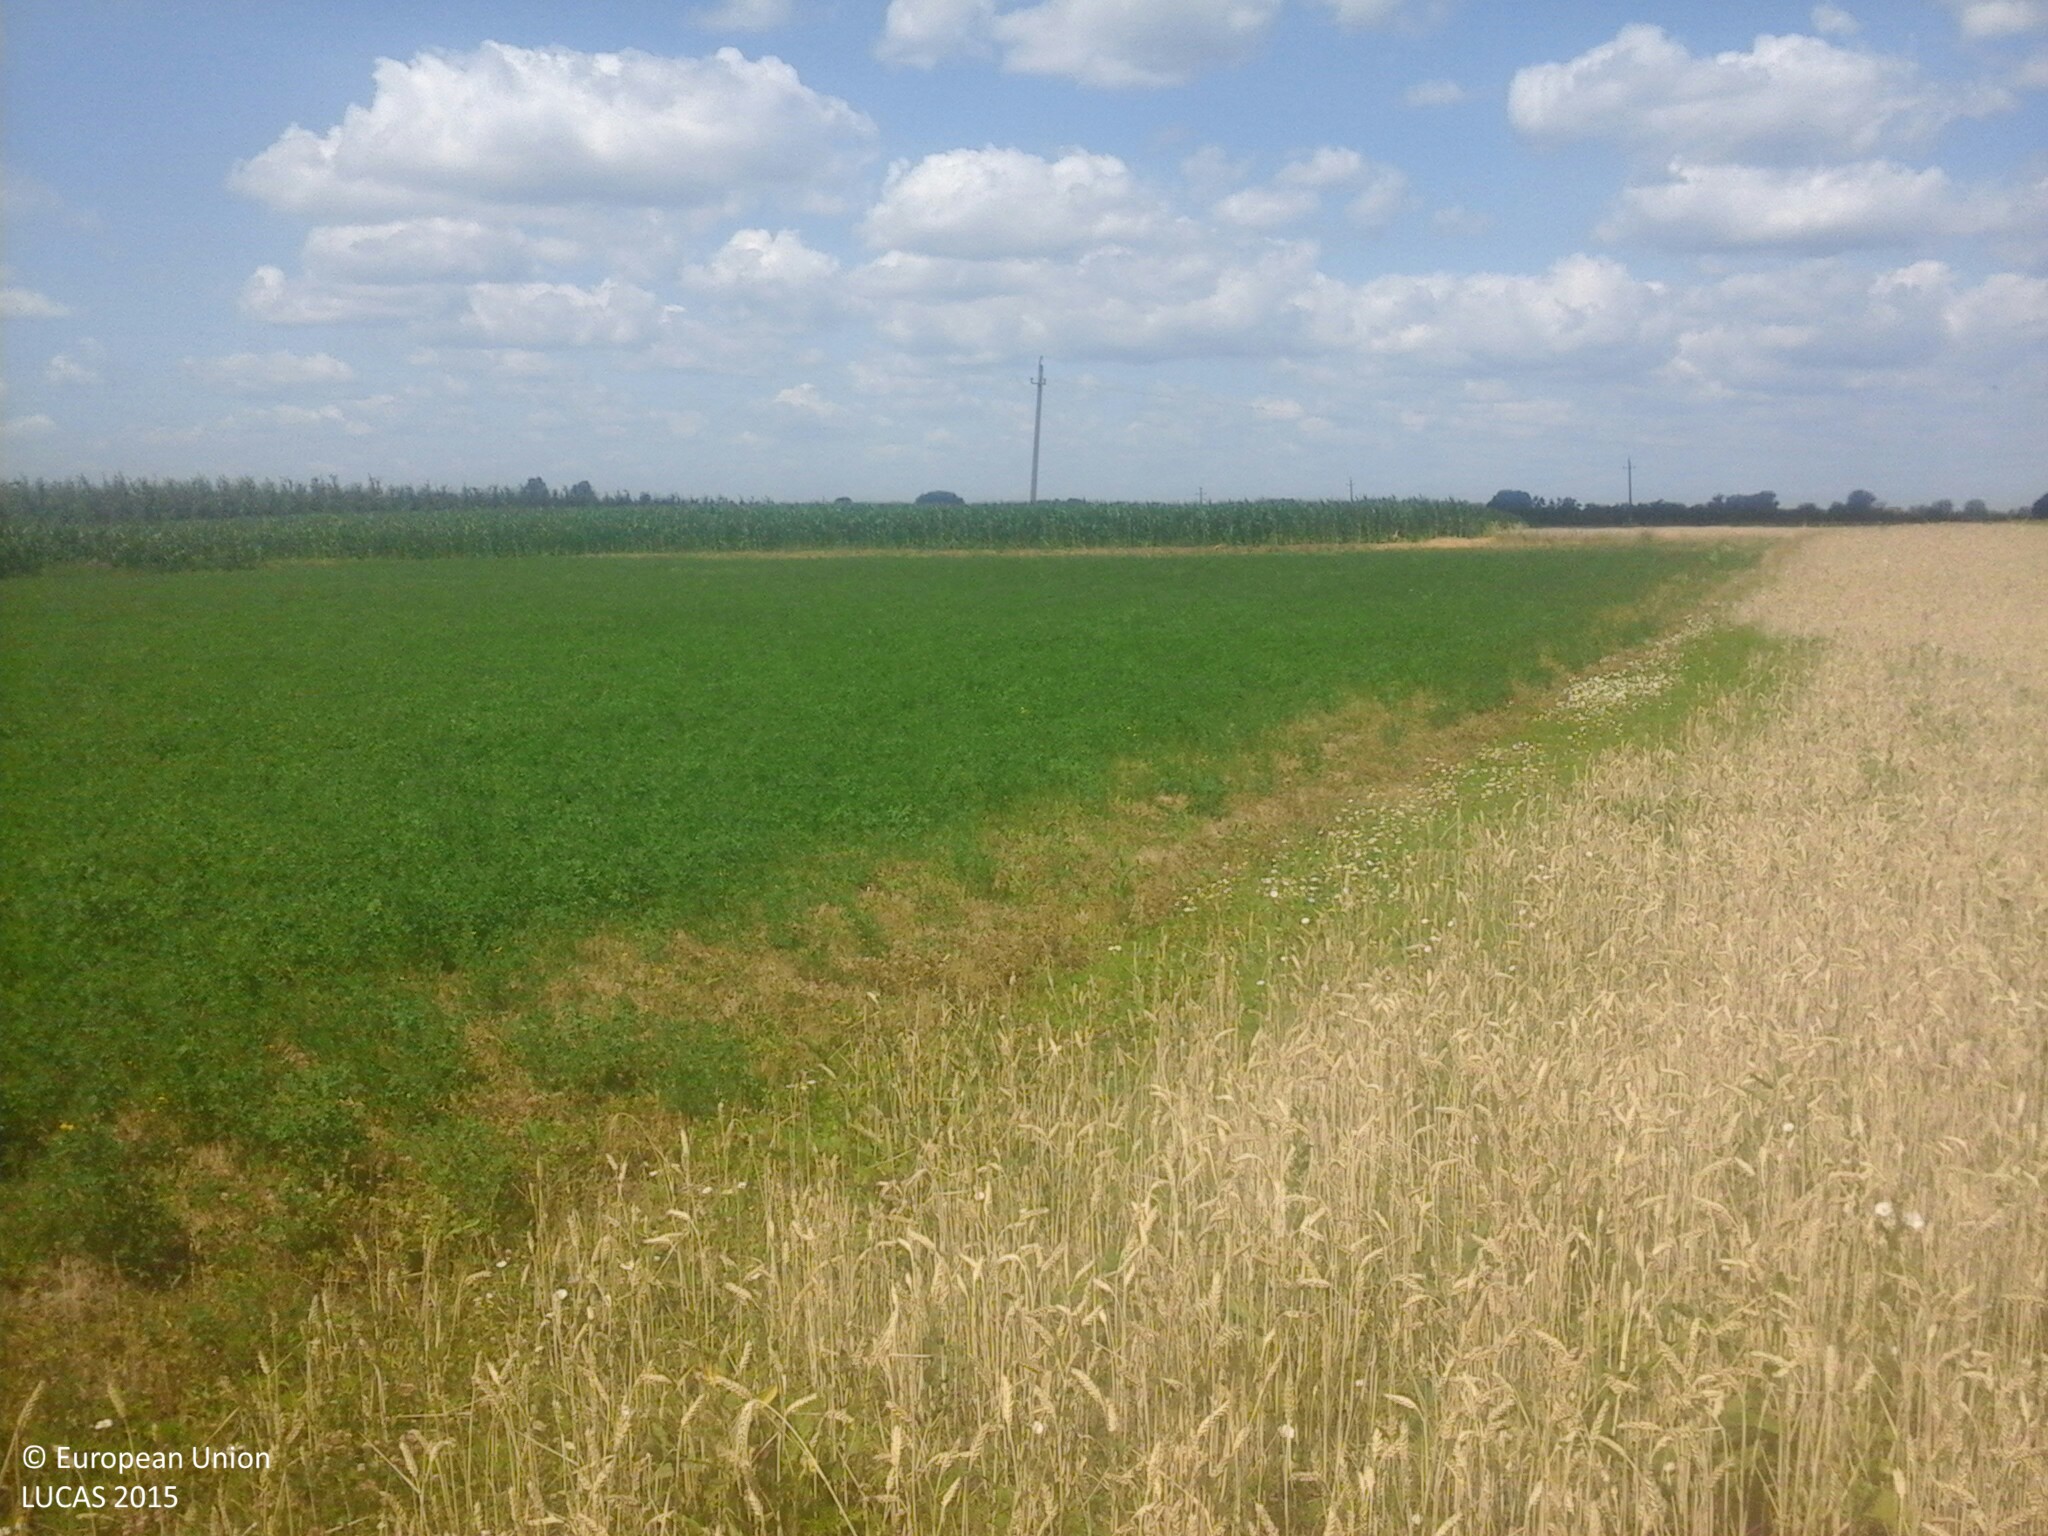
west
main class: Cropland
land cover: Triticale
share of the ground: > 75 %
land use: Agriculture (excluding fallow land and kitchen gardens)
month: July
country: HU
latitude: 48.0527
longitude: 22.3603
